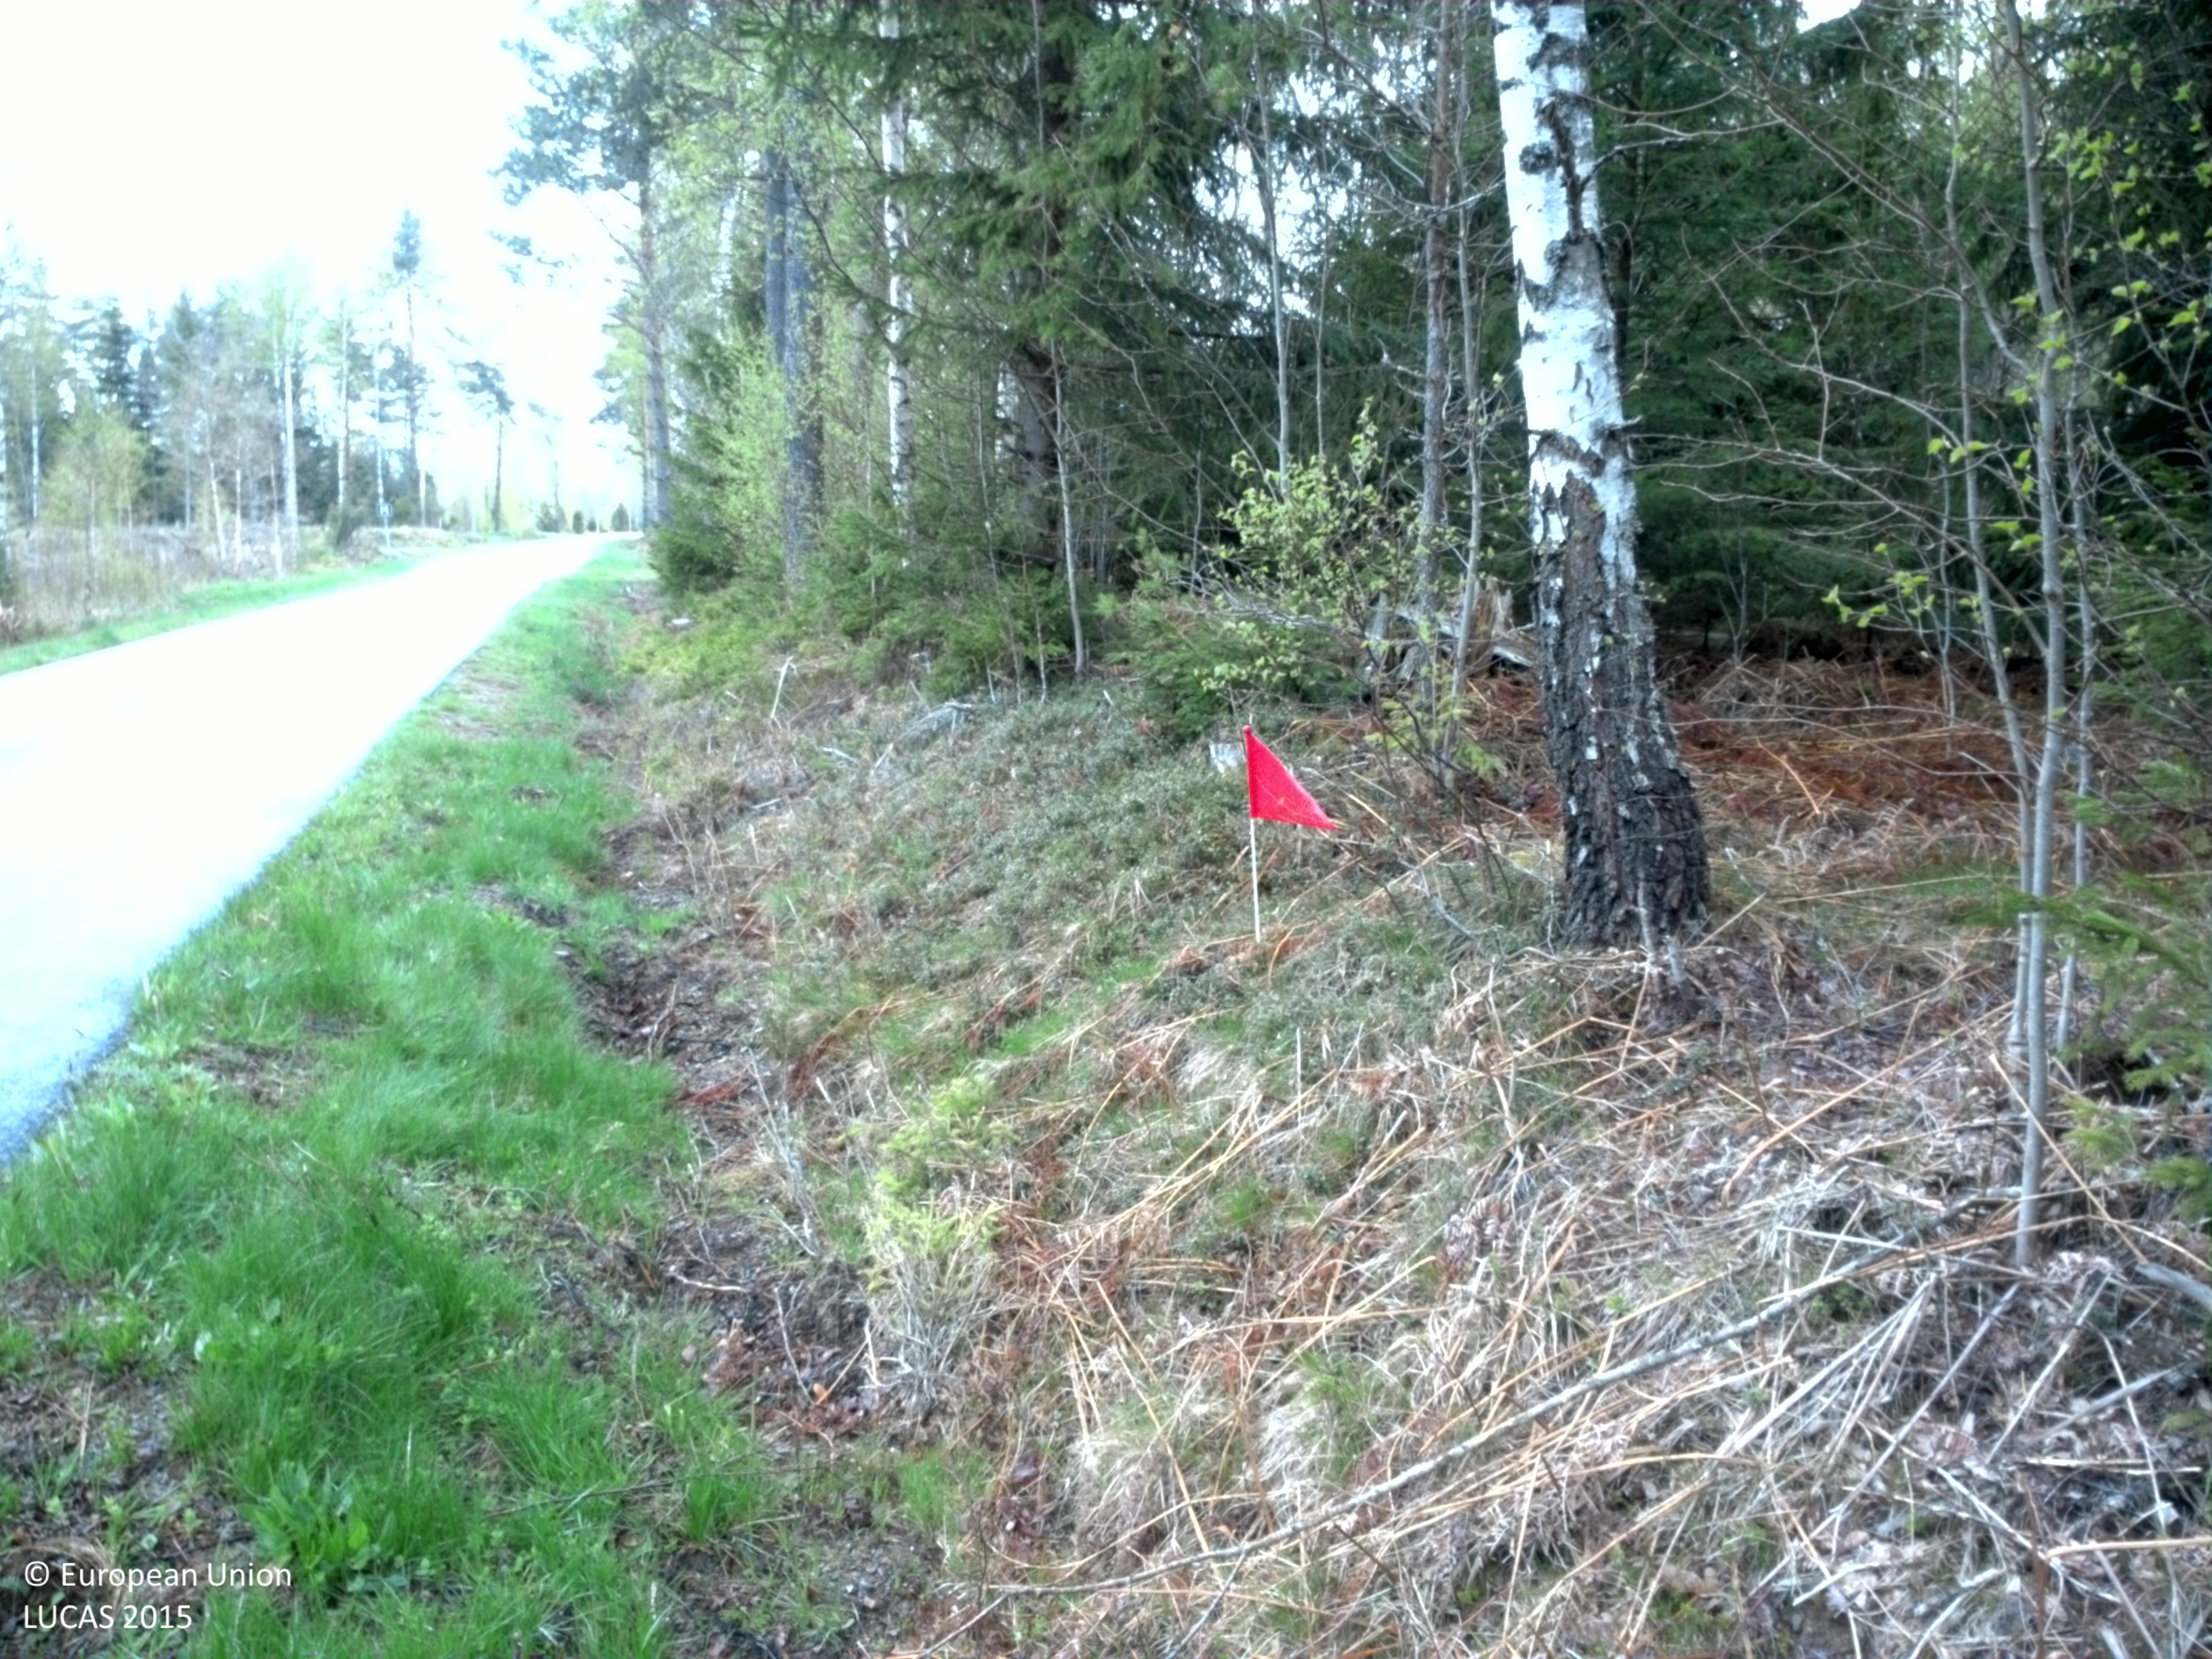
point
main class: Woodland
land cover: Spruce dominated mixed woodland
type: boreal forest
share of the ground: > 75 %
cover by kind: coniferous forest trees 40 %, broadleaved forest trees 40 %, herbaceous plants 10 %, lichens and mosses 10 %
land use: Forestry
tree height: > 5 m
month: May
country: SE
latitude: 56.6462
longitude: 15.0698
